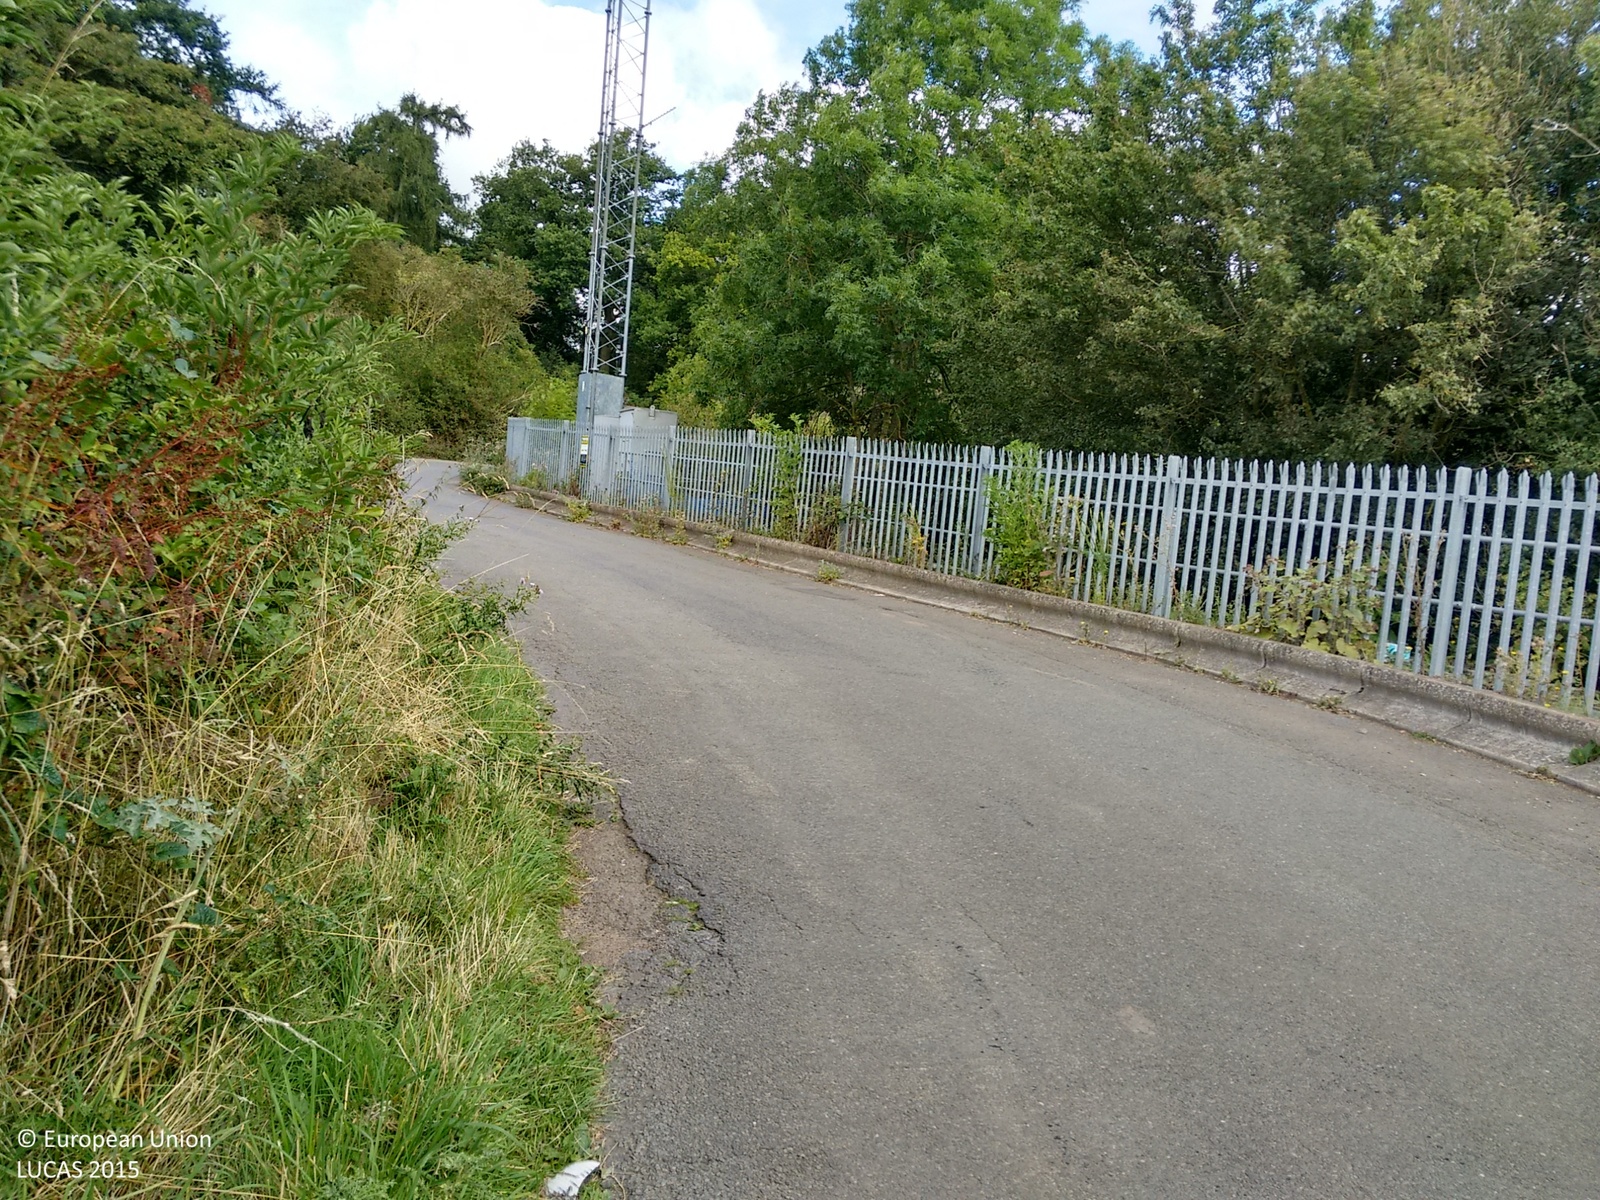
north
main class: Grassland
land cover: Grassland without tree/shrub cover
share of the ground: > 75 %
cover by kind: herbaceous plants 100 %
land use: Agriculture (excluding fallow land and kitchen gardens)
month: August
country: GB
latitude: 52.3221
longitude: -1.1526
